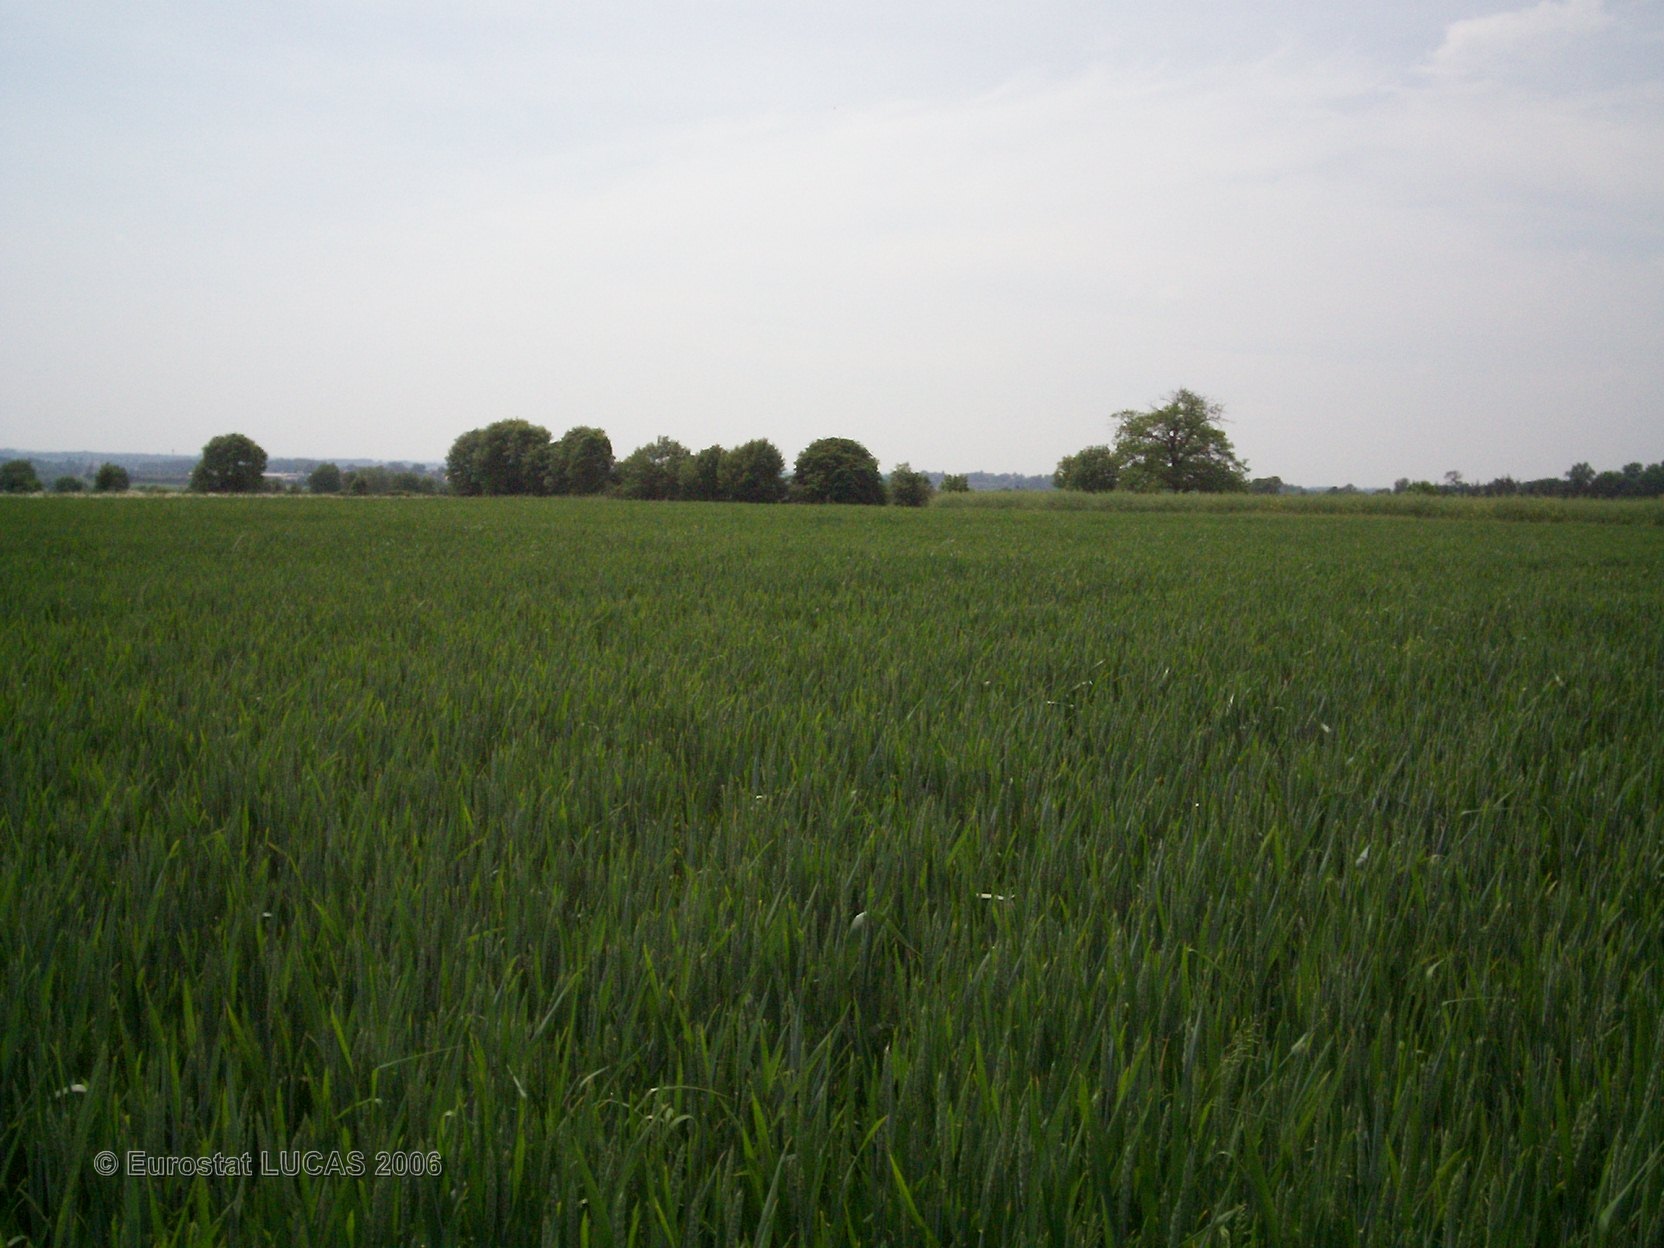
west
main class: Cropland
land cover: Common wheat
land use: Agriculture (excluding fallow land and kitchen gardens)
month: May
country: FR
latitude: 46.4698
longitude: -0.2996
